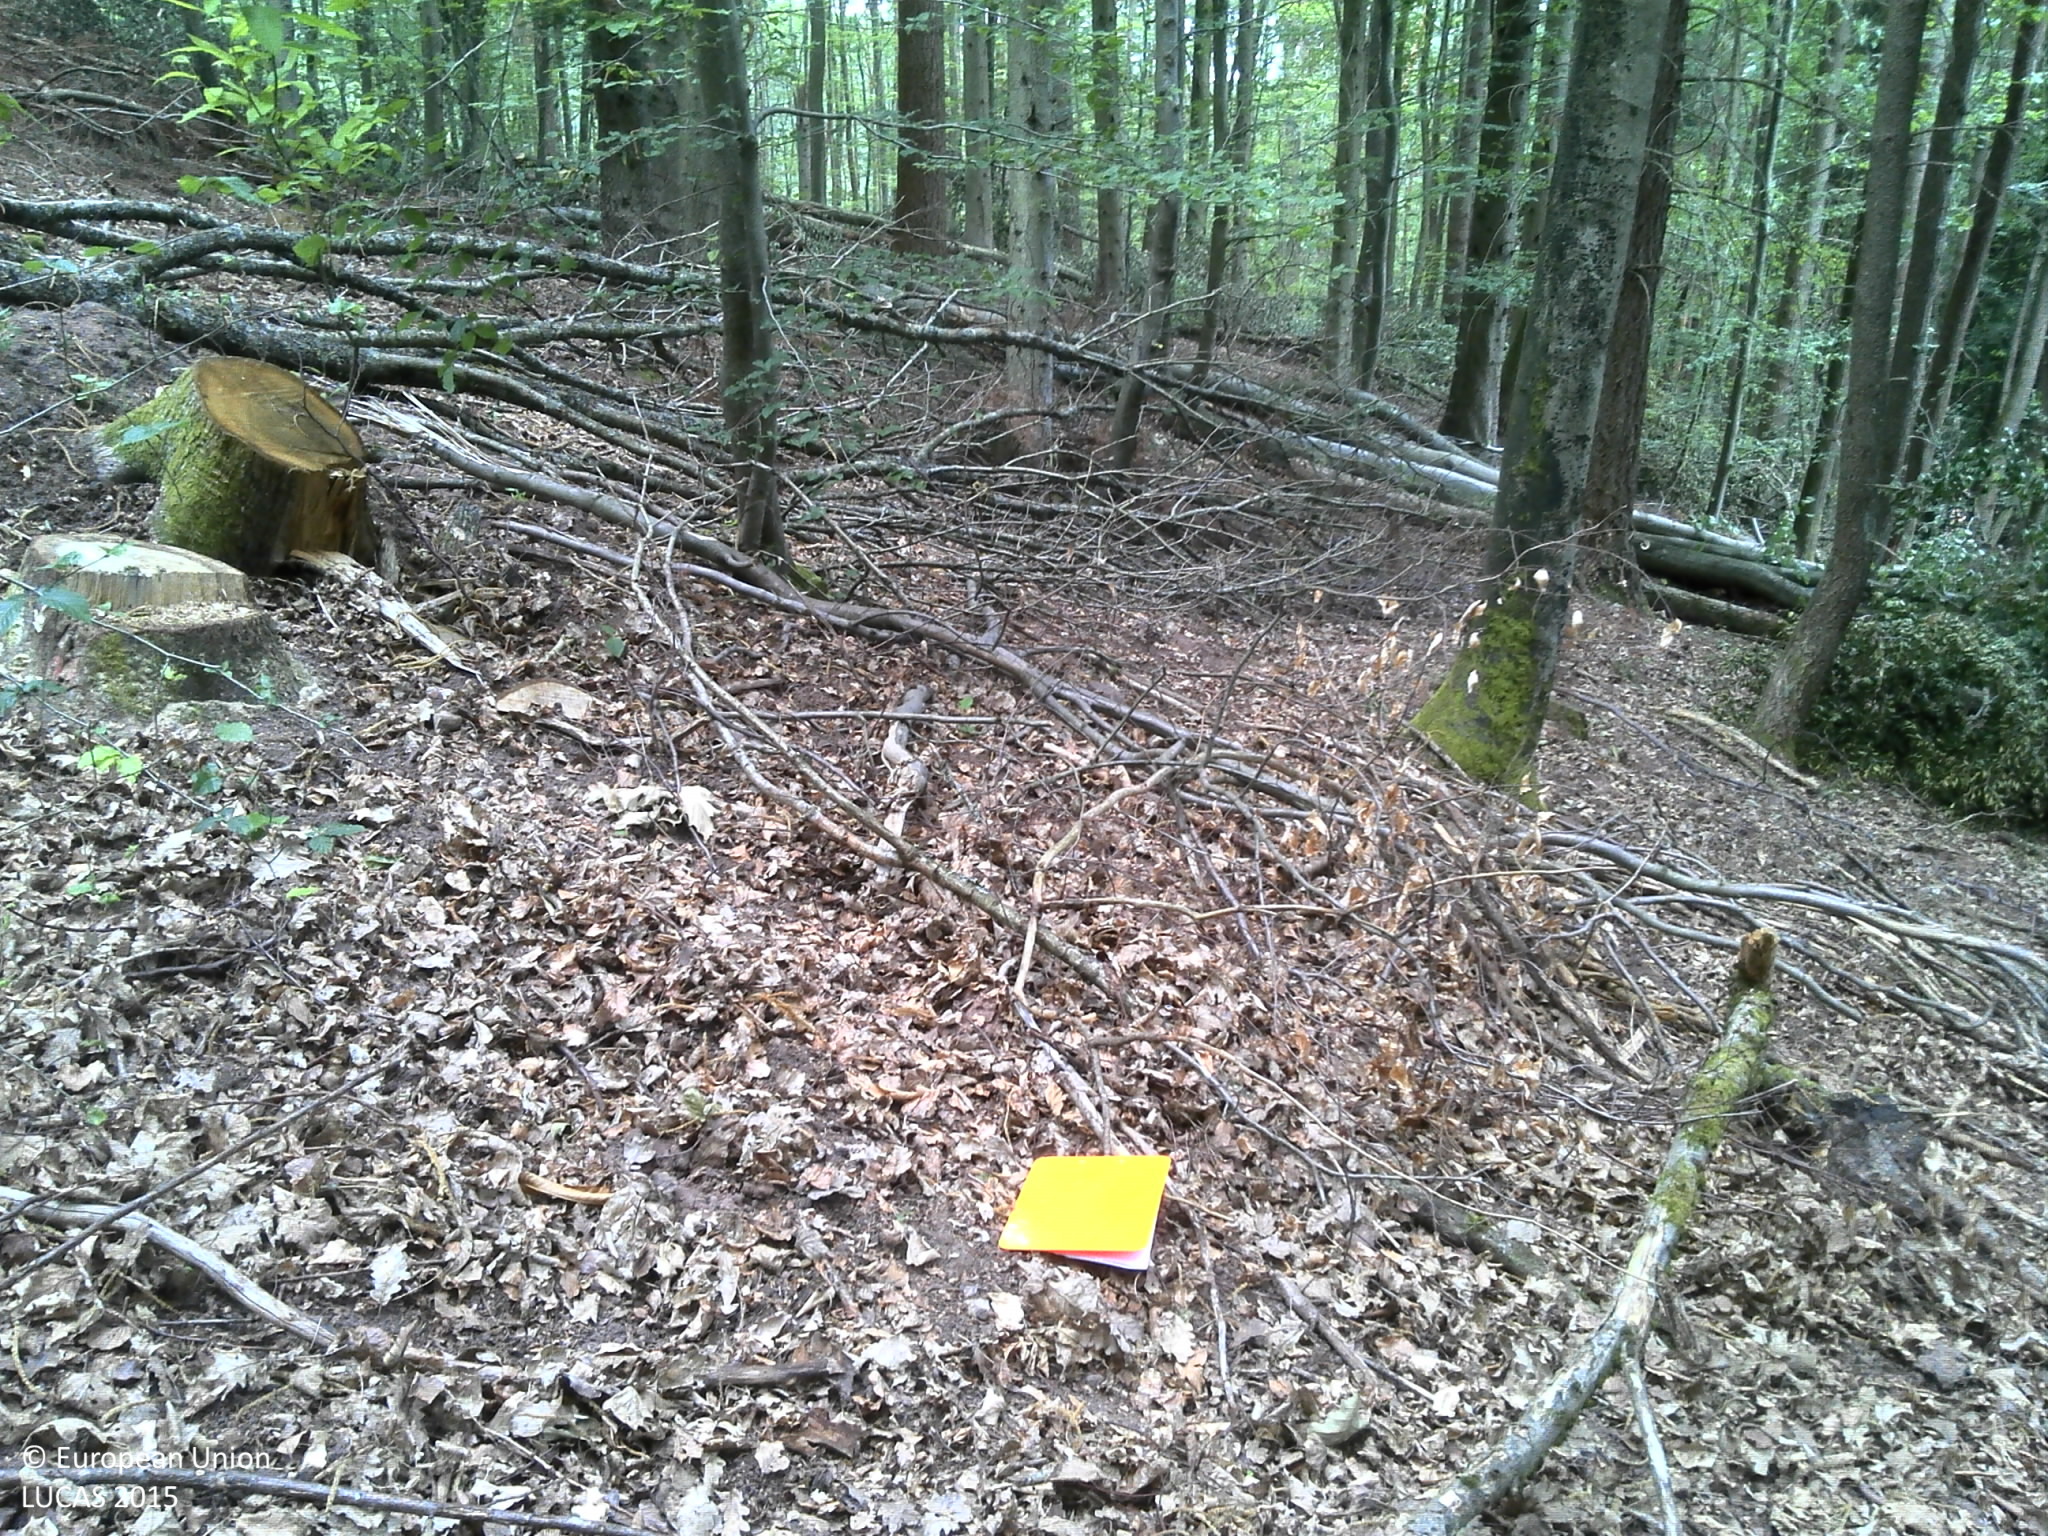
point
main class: Woodland
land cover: Spruce dominated mixed woodland
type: hemiboreal forest and nemoral coniferous forest and mixed broadleaved-coniferous forest
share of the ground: > 75 %
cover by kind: broadleaved forest trees 65 %, coniferous forest trees 35 %
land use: Forestry
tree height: > 5 m
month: July
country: FR
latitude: 49.0387
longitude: 7.3878
